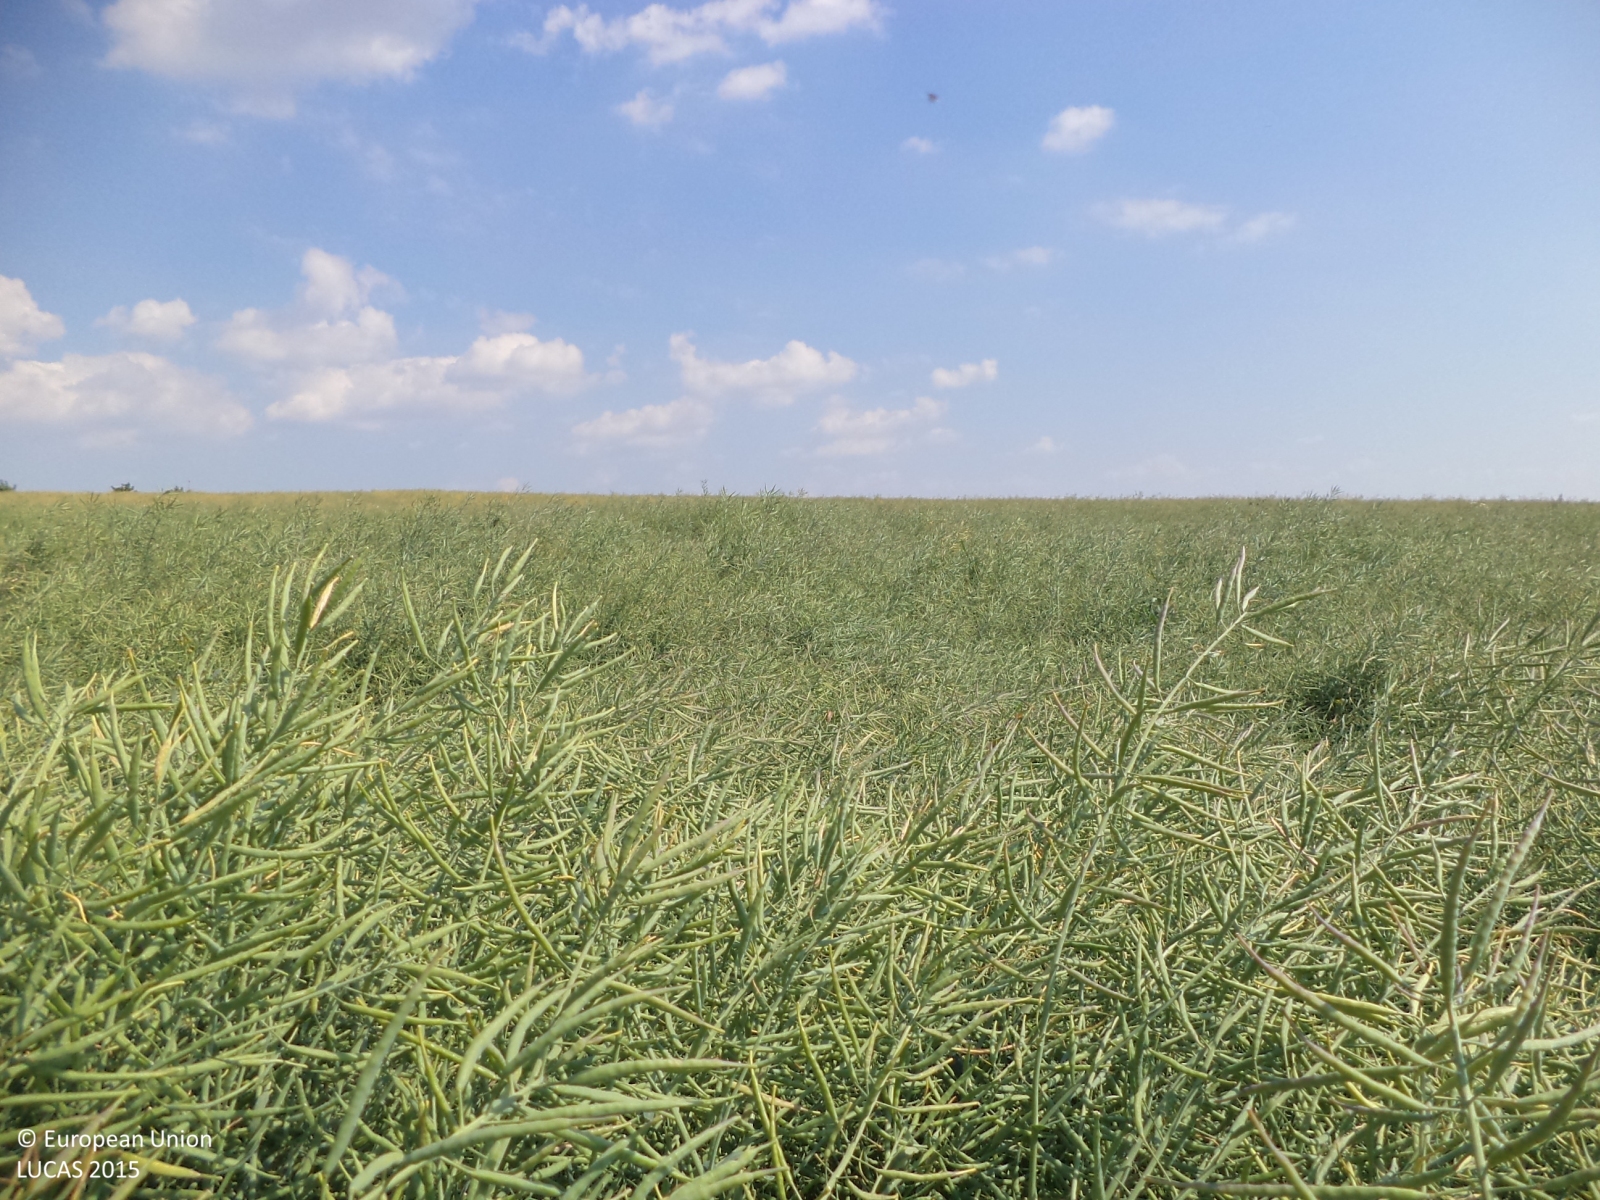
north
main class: Cropland
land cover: Rape and turnip rape
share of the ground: > 75 %
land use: Agriculture (excluding fallow land and kitchen gardens)
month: July
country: CZ
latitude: 49.3622
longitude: 14.3660
